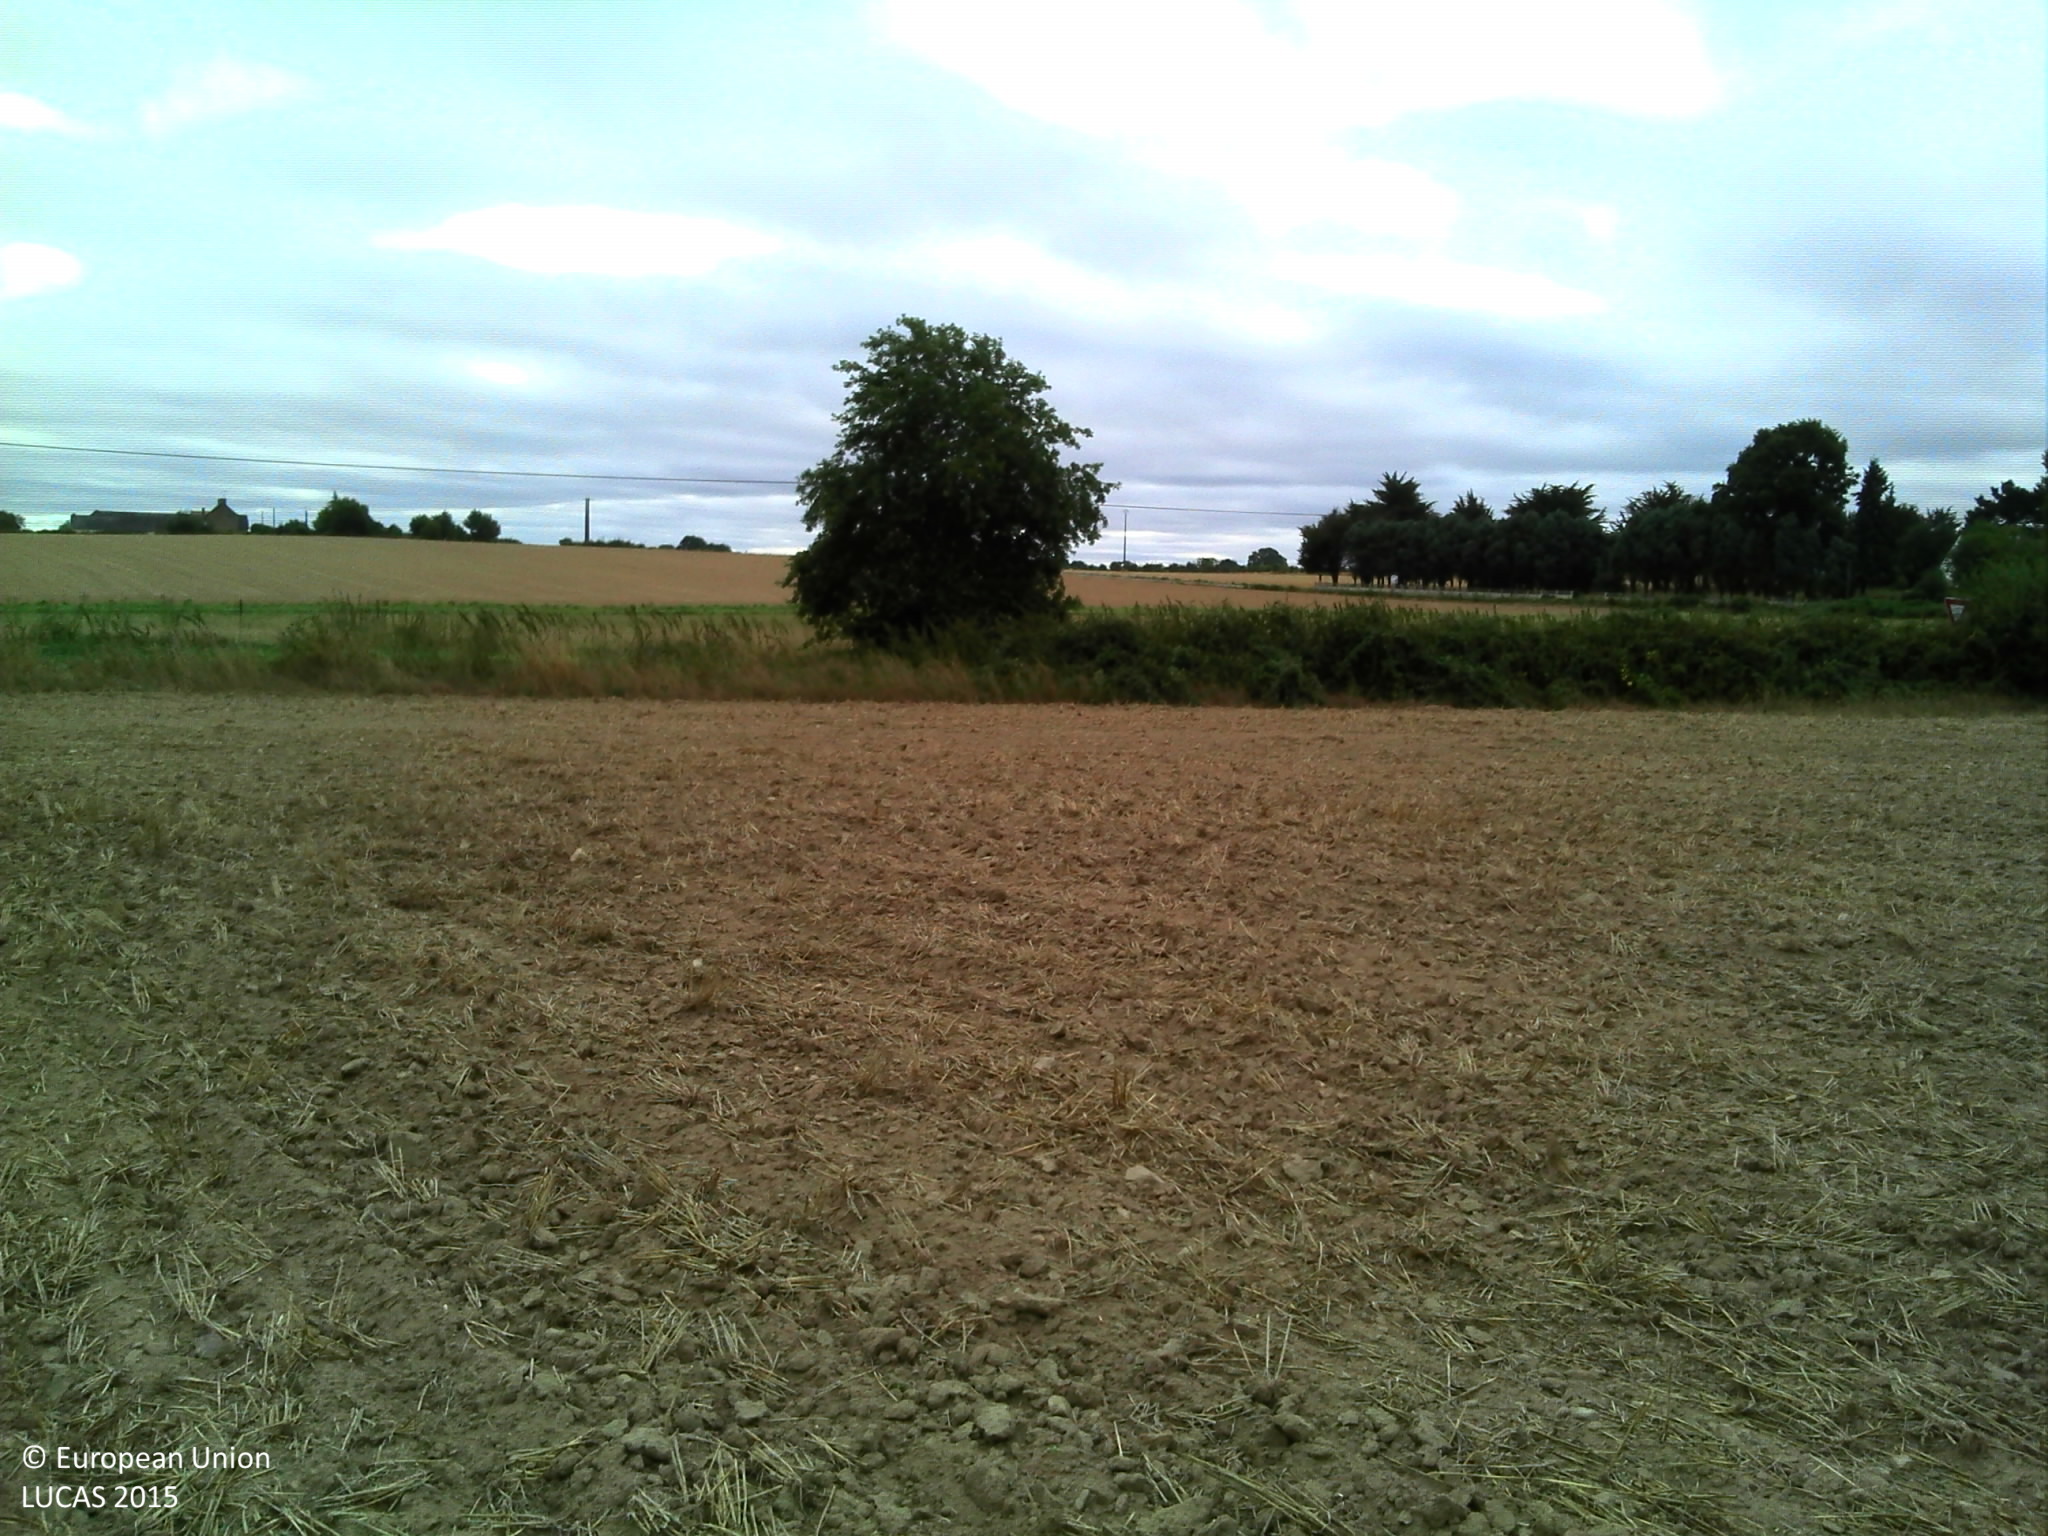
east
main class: Cropland
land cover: Common wheat
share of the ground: < 10 %
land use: Agriculture (excluding fallow land and kitchen gardens)
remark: Tilled/Sowed
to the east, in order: Common wheat; Grass margins; Paved roads, cycling and walking lanes; Grass margins; Electric lines; Spontaneously vegetated surfaces; Ditches and canals; Temporary grasslands; Spontaneously vegetated surfaces; Ditches and canals; Tracks; Common wheat
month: August
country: FR
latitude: 47.7277
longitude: -1.3346
